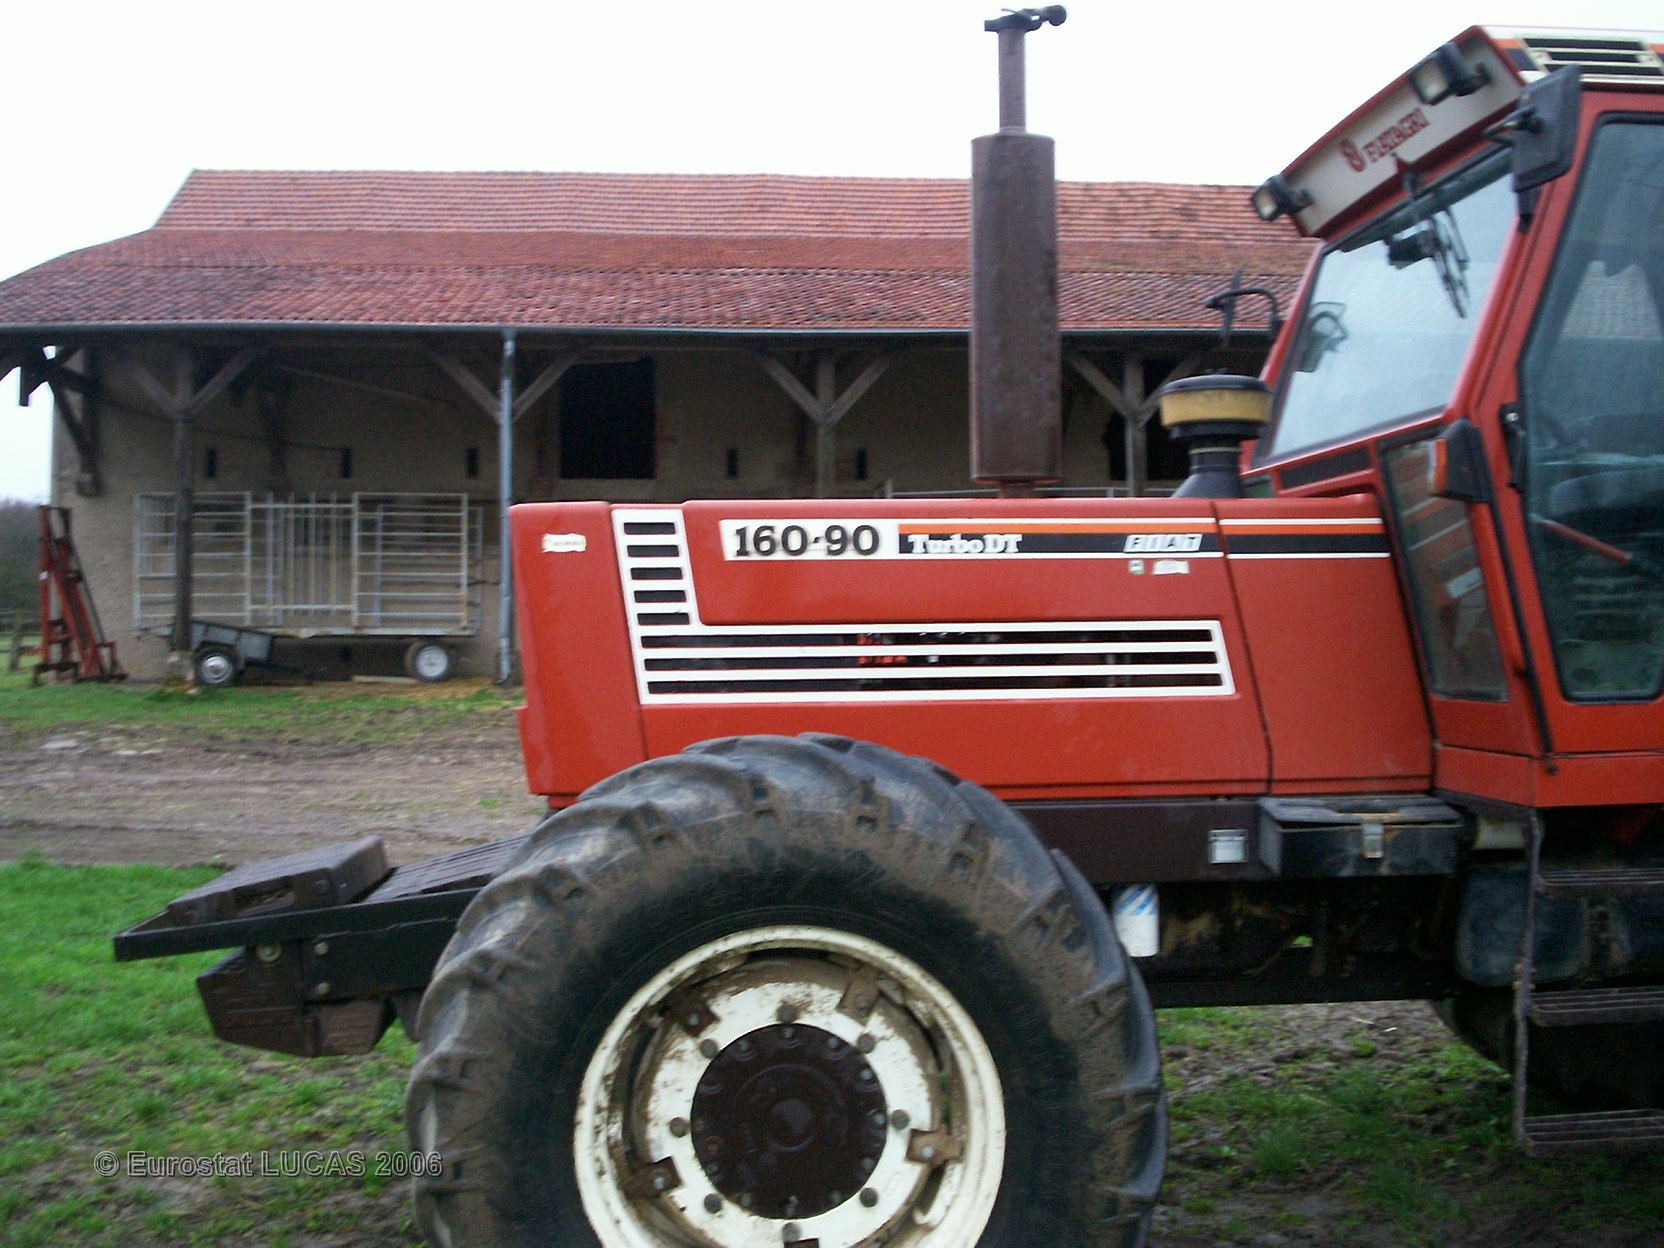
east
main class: Grassland
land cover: Grassland without tree/shrub cover
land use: Agriculture (excluding fallow land and kitchen gardens)
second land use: Residential
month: April
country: FR
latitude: 48.7228
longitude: 6.9964
